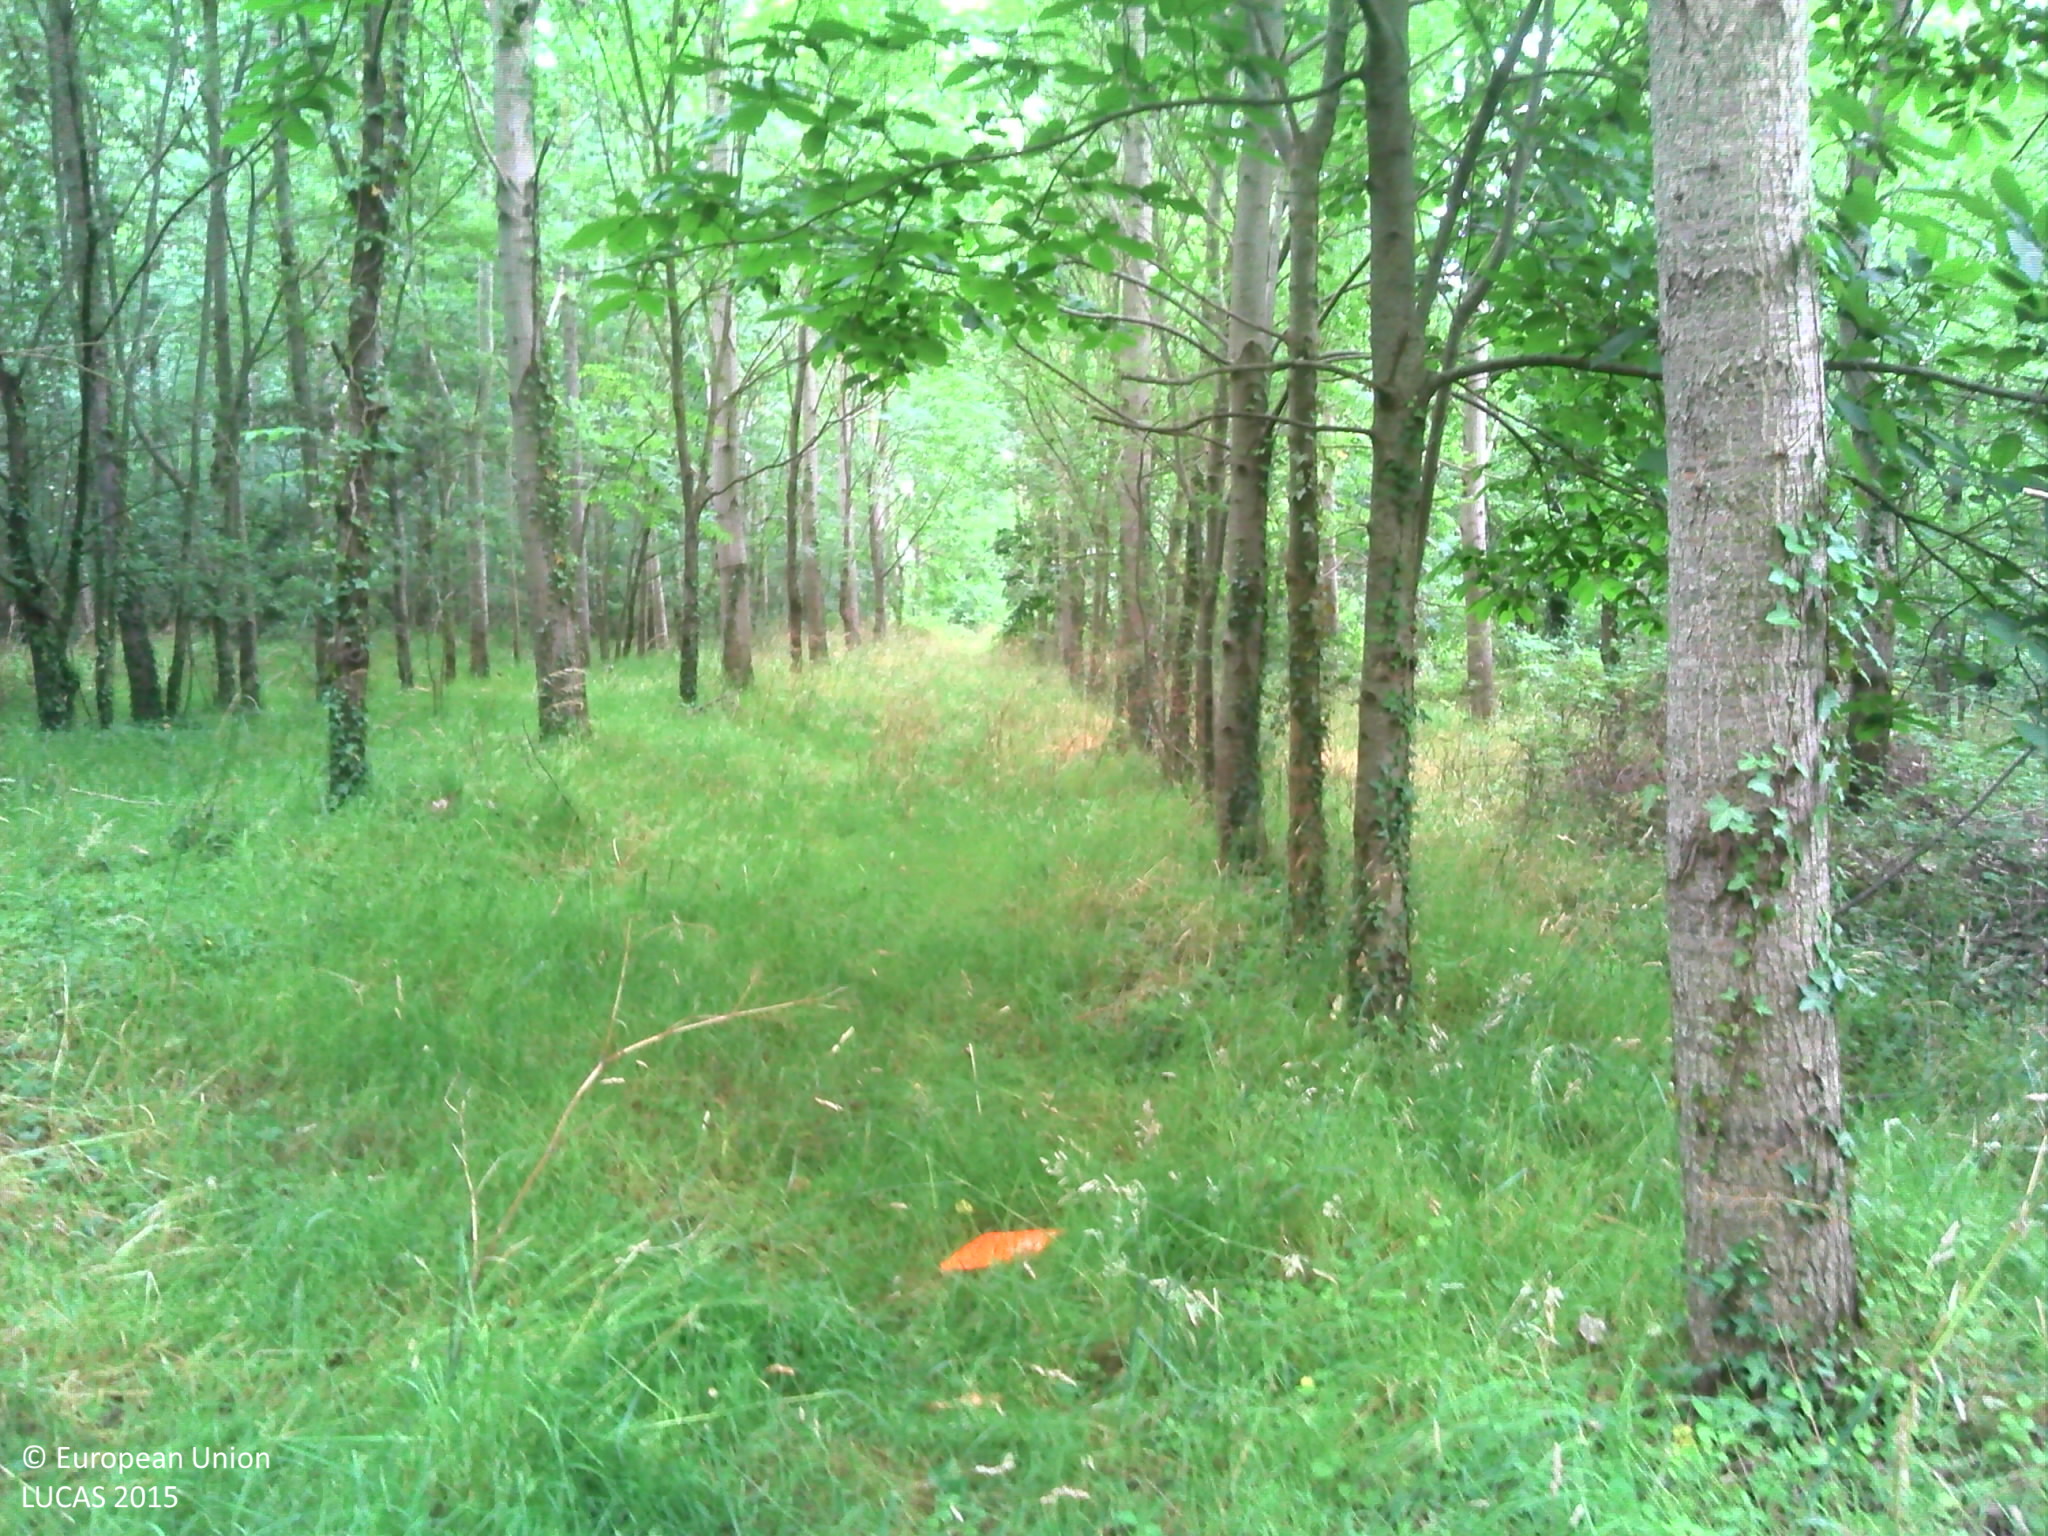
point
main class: Woodland
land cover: Broadleaved woodland
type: mesophytic deciduous forest
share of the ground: > 75 %
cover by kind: broadleaved forest trees 80 %, herbaceous plants 20 %
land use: Forestry
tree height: > 5 m
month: July
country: FR
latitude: 46.7672
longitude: -1.8152
